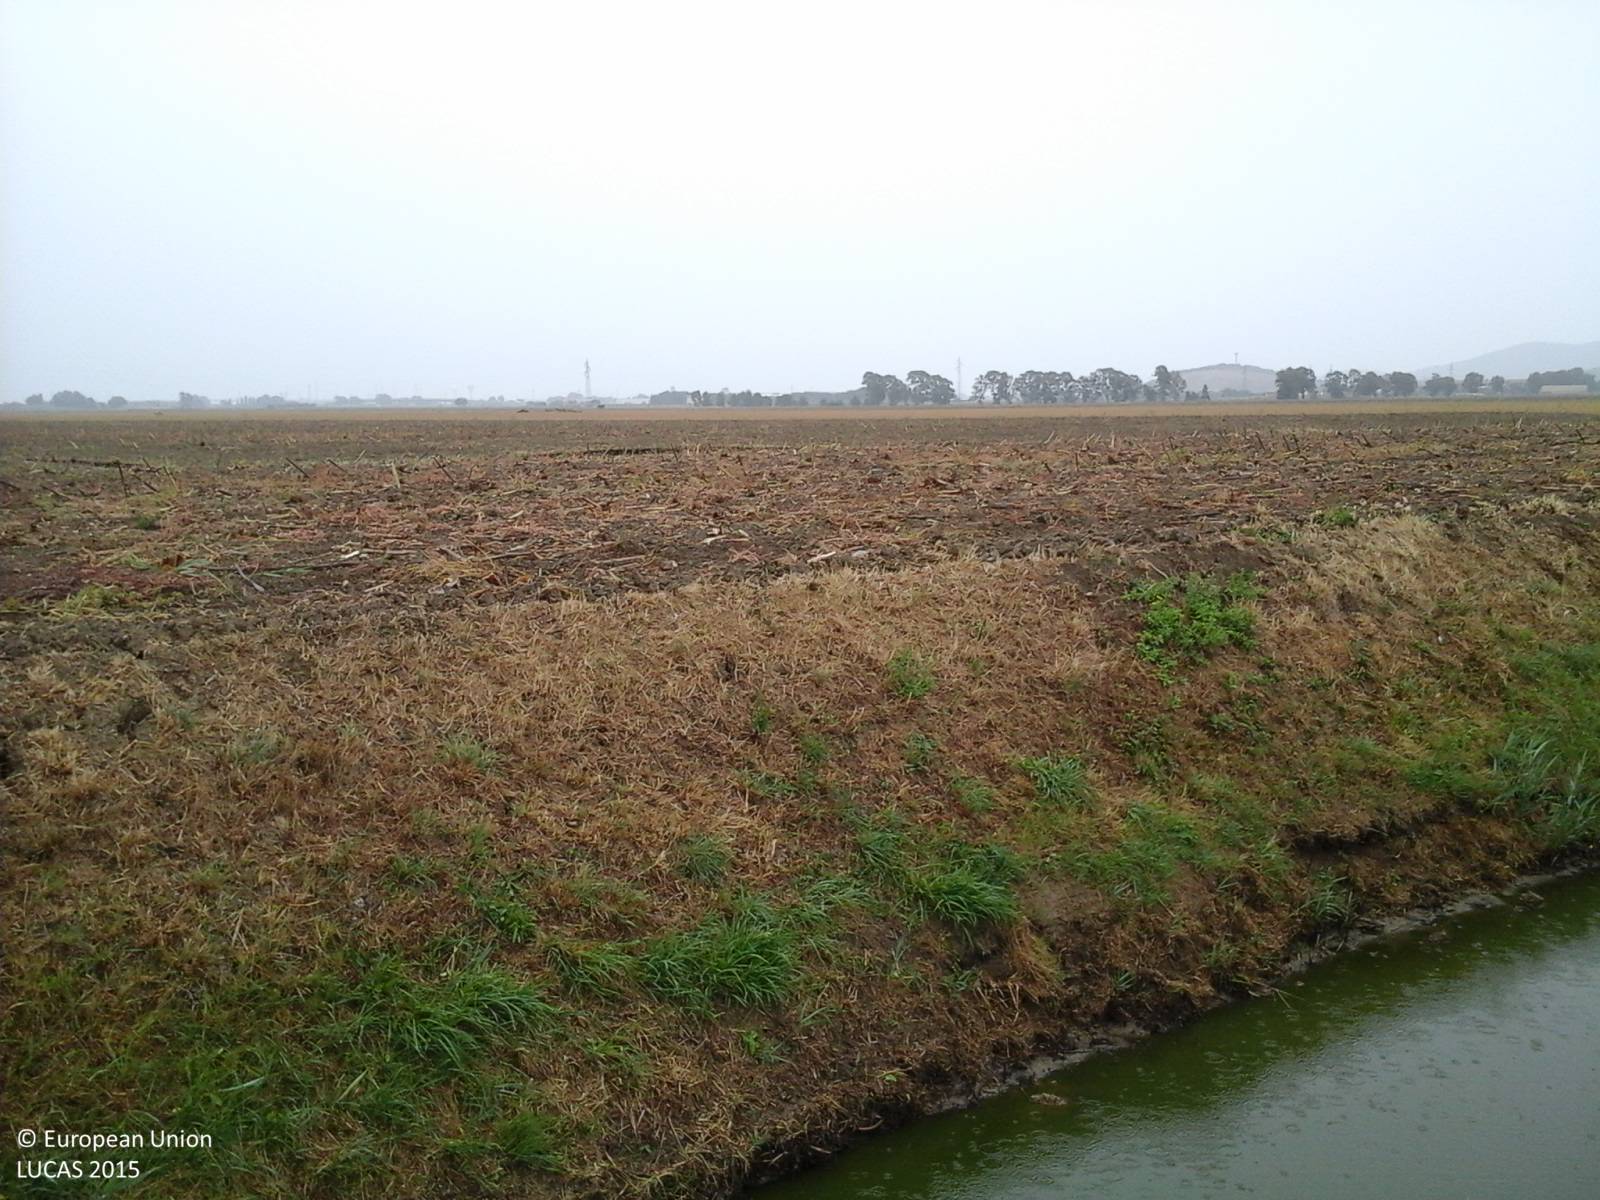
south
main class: Cropland
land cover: Sunflower
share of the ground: < 10 %
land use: Agriculture (excluding fallow land and kitchen gardens)
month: October
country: IT
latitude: 42.9956
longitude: 10.5502
